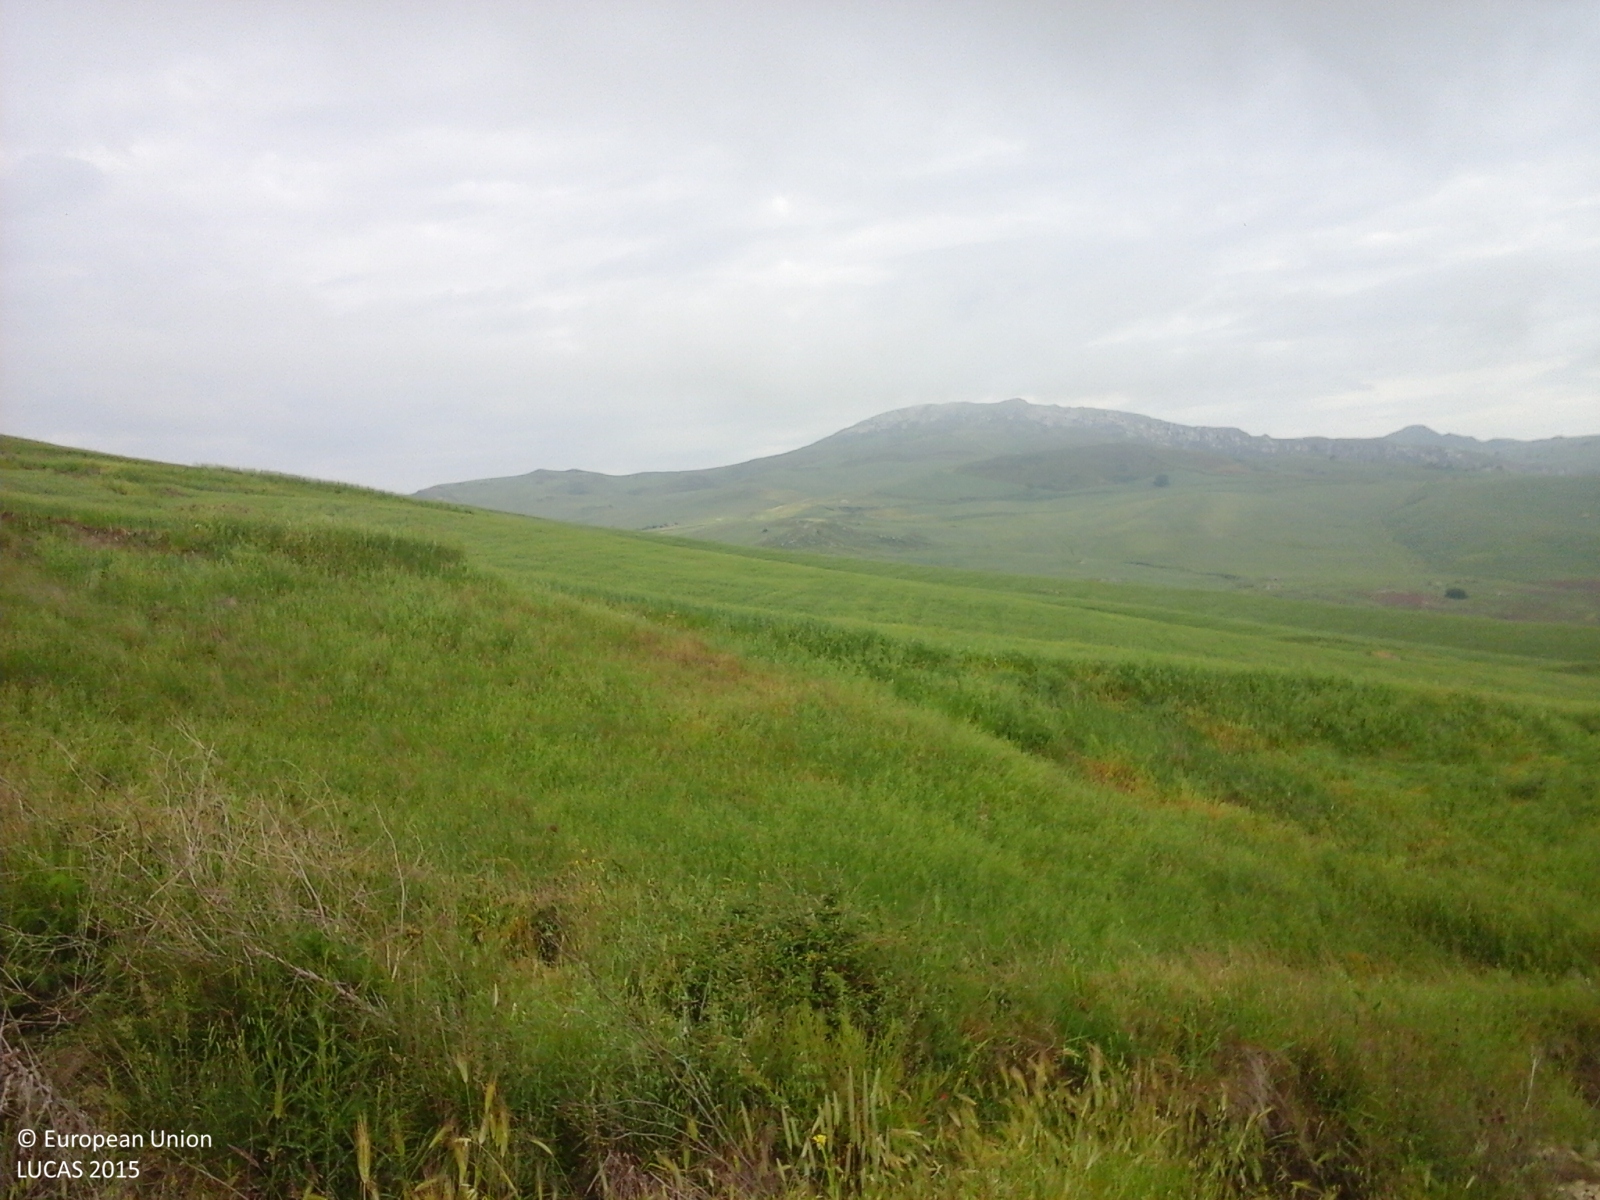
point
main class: Cropland
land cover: Durum wheat
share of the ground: > 75 %
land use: Agriculture (excluding fallow land and kitchen gardens)
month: May
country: IT
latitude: 37.7371
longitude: 13.9769
